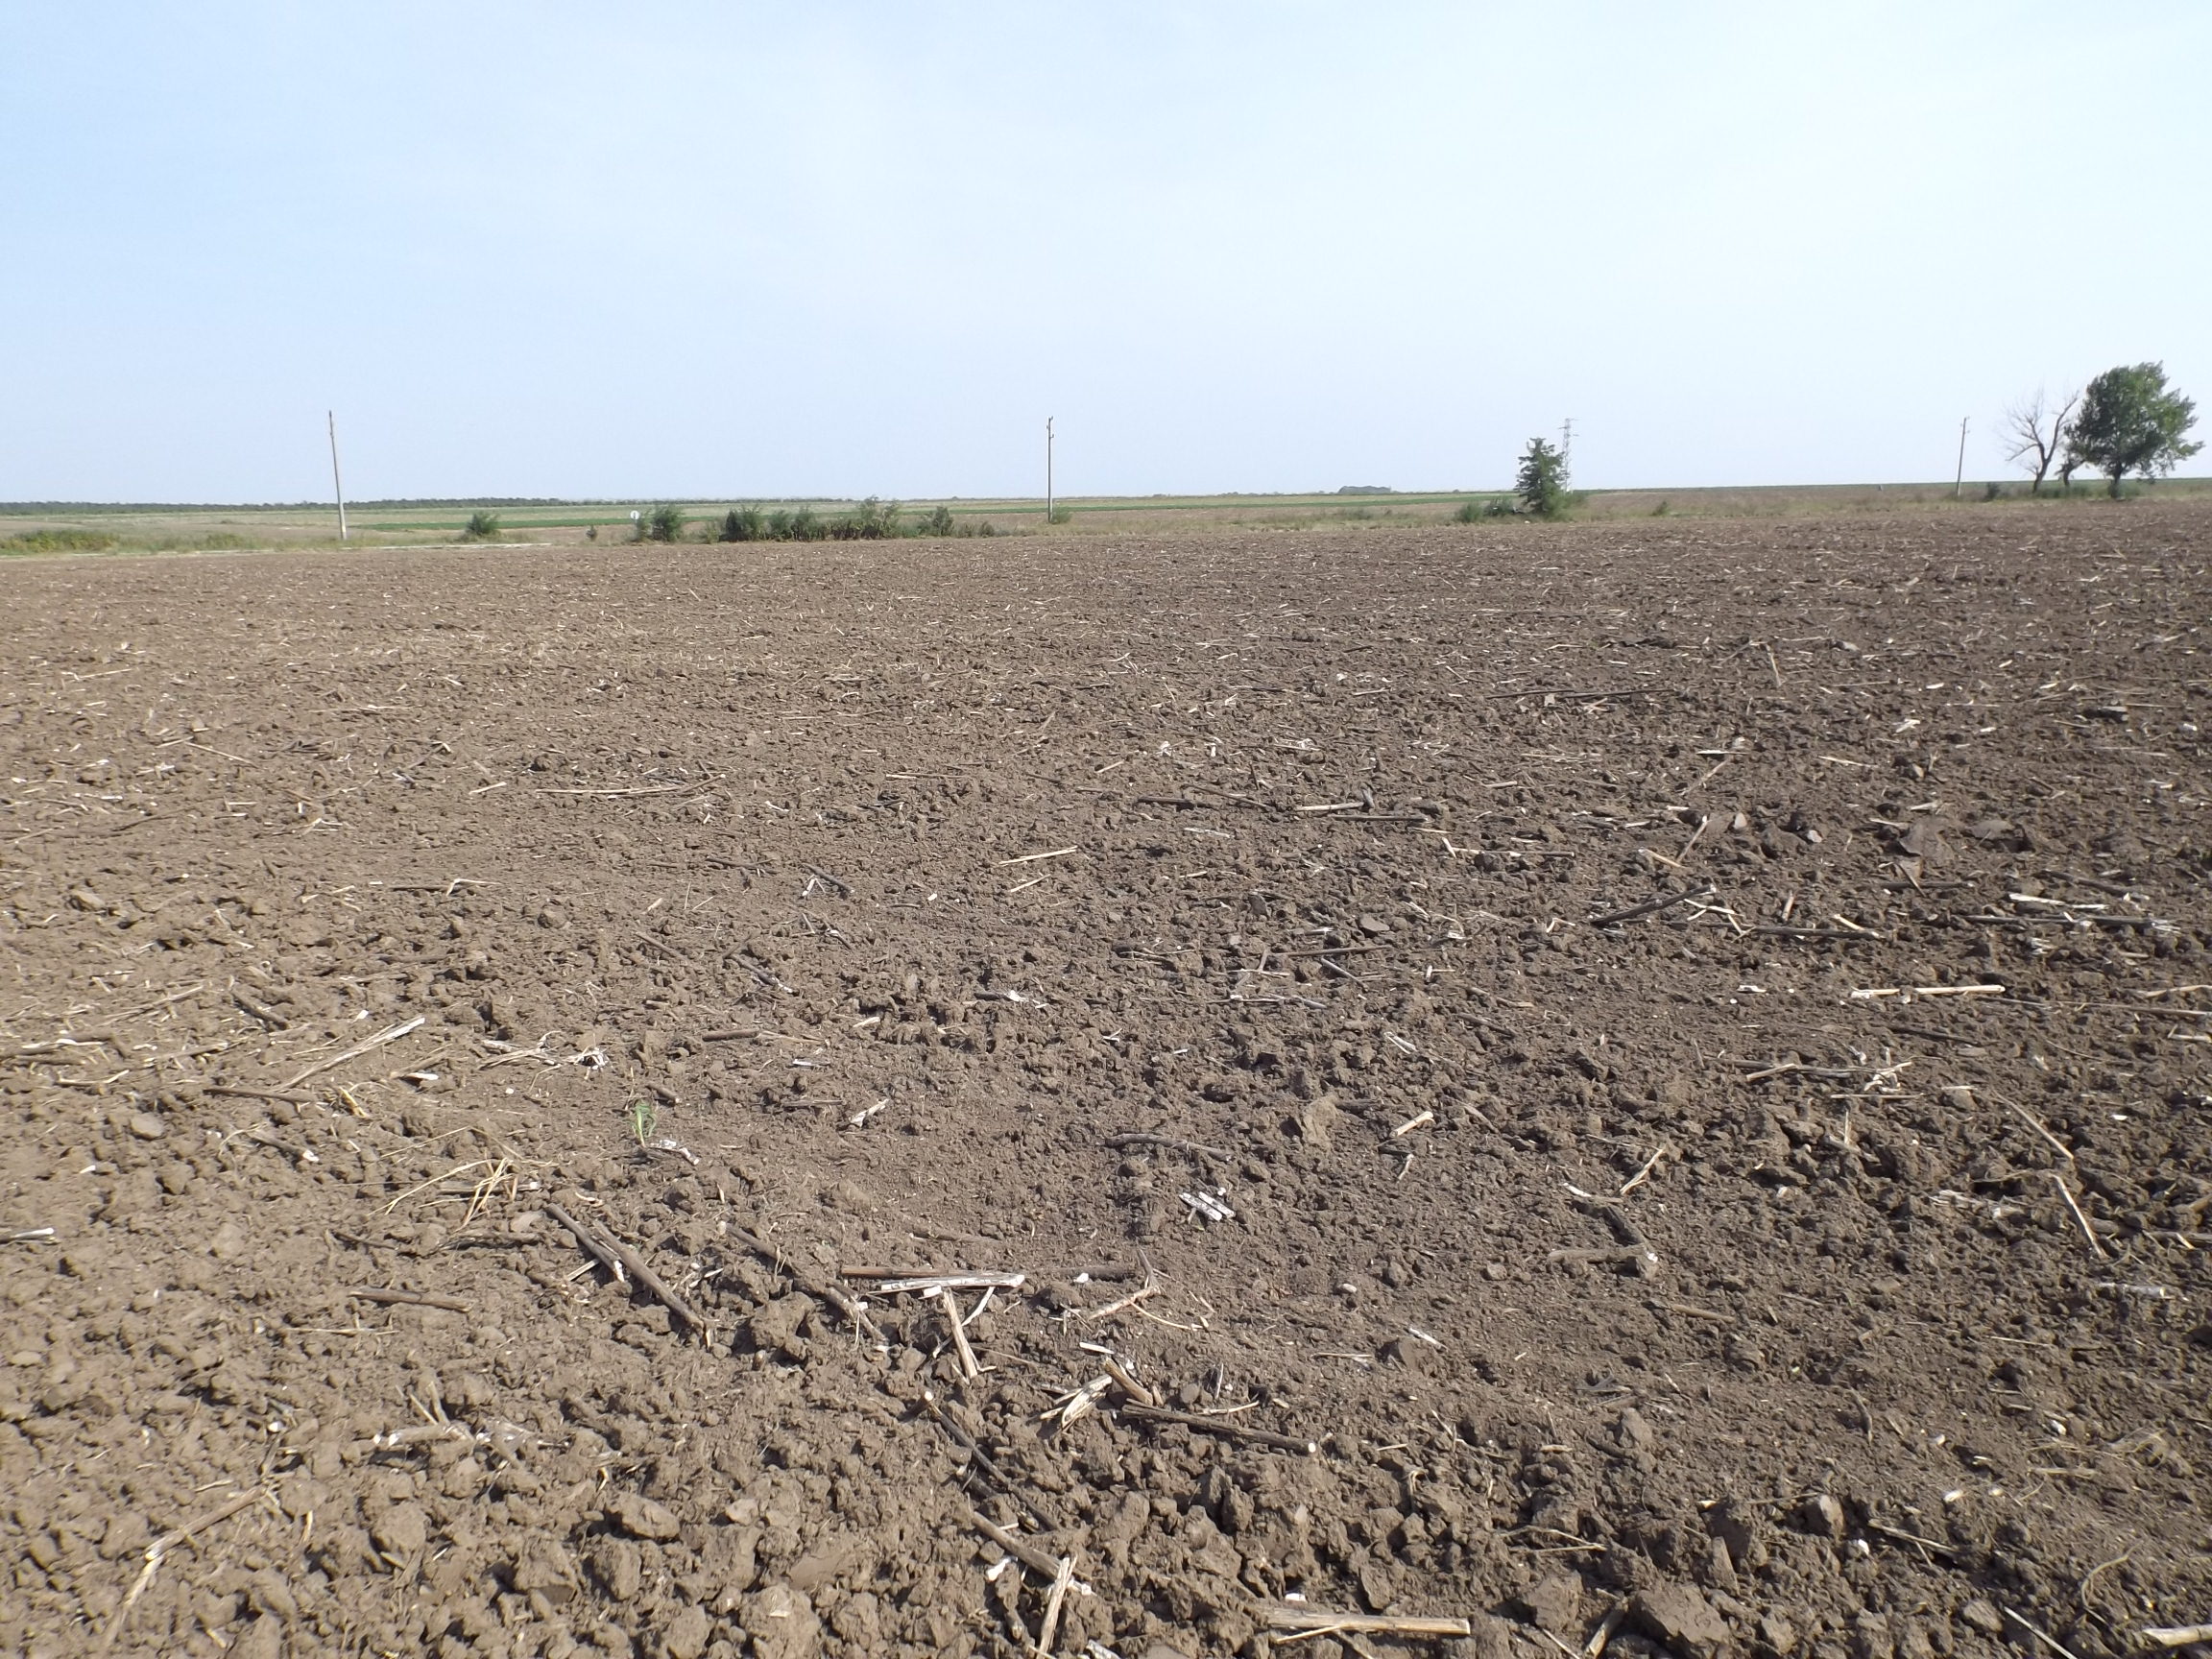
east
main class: Cropland
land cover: Sunflower
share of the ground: < 10 %
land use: Agriculture (excluding fallow land and kitchen gardens)
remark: Harvested field
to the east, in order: Sunflower; Grass margins; Paved roads, cycling and walking lanes; Grass margins; Sunflower; Electric lines; Sunflower
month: September
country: BG
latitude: 43.9922
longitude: 26.8402
